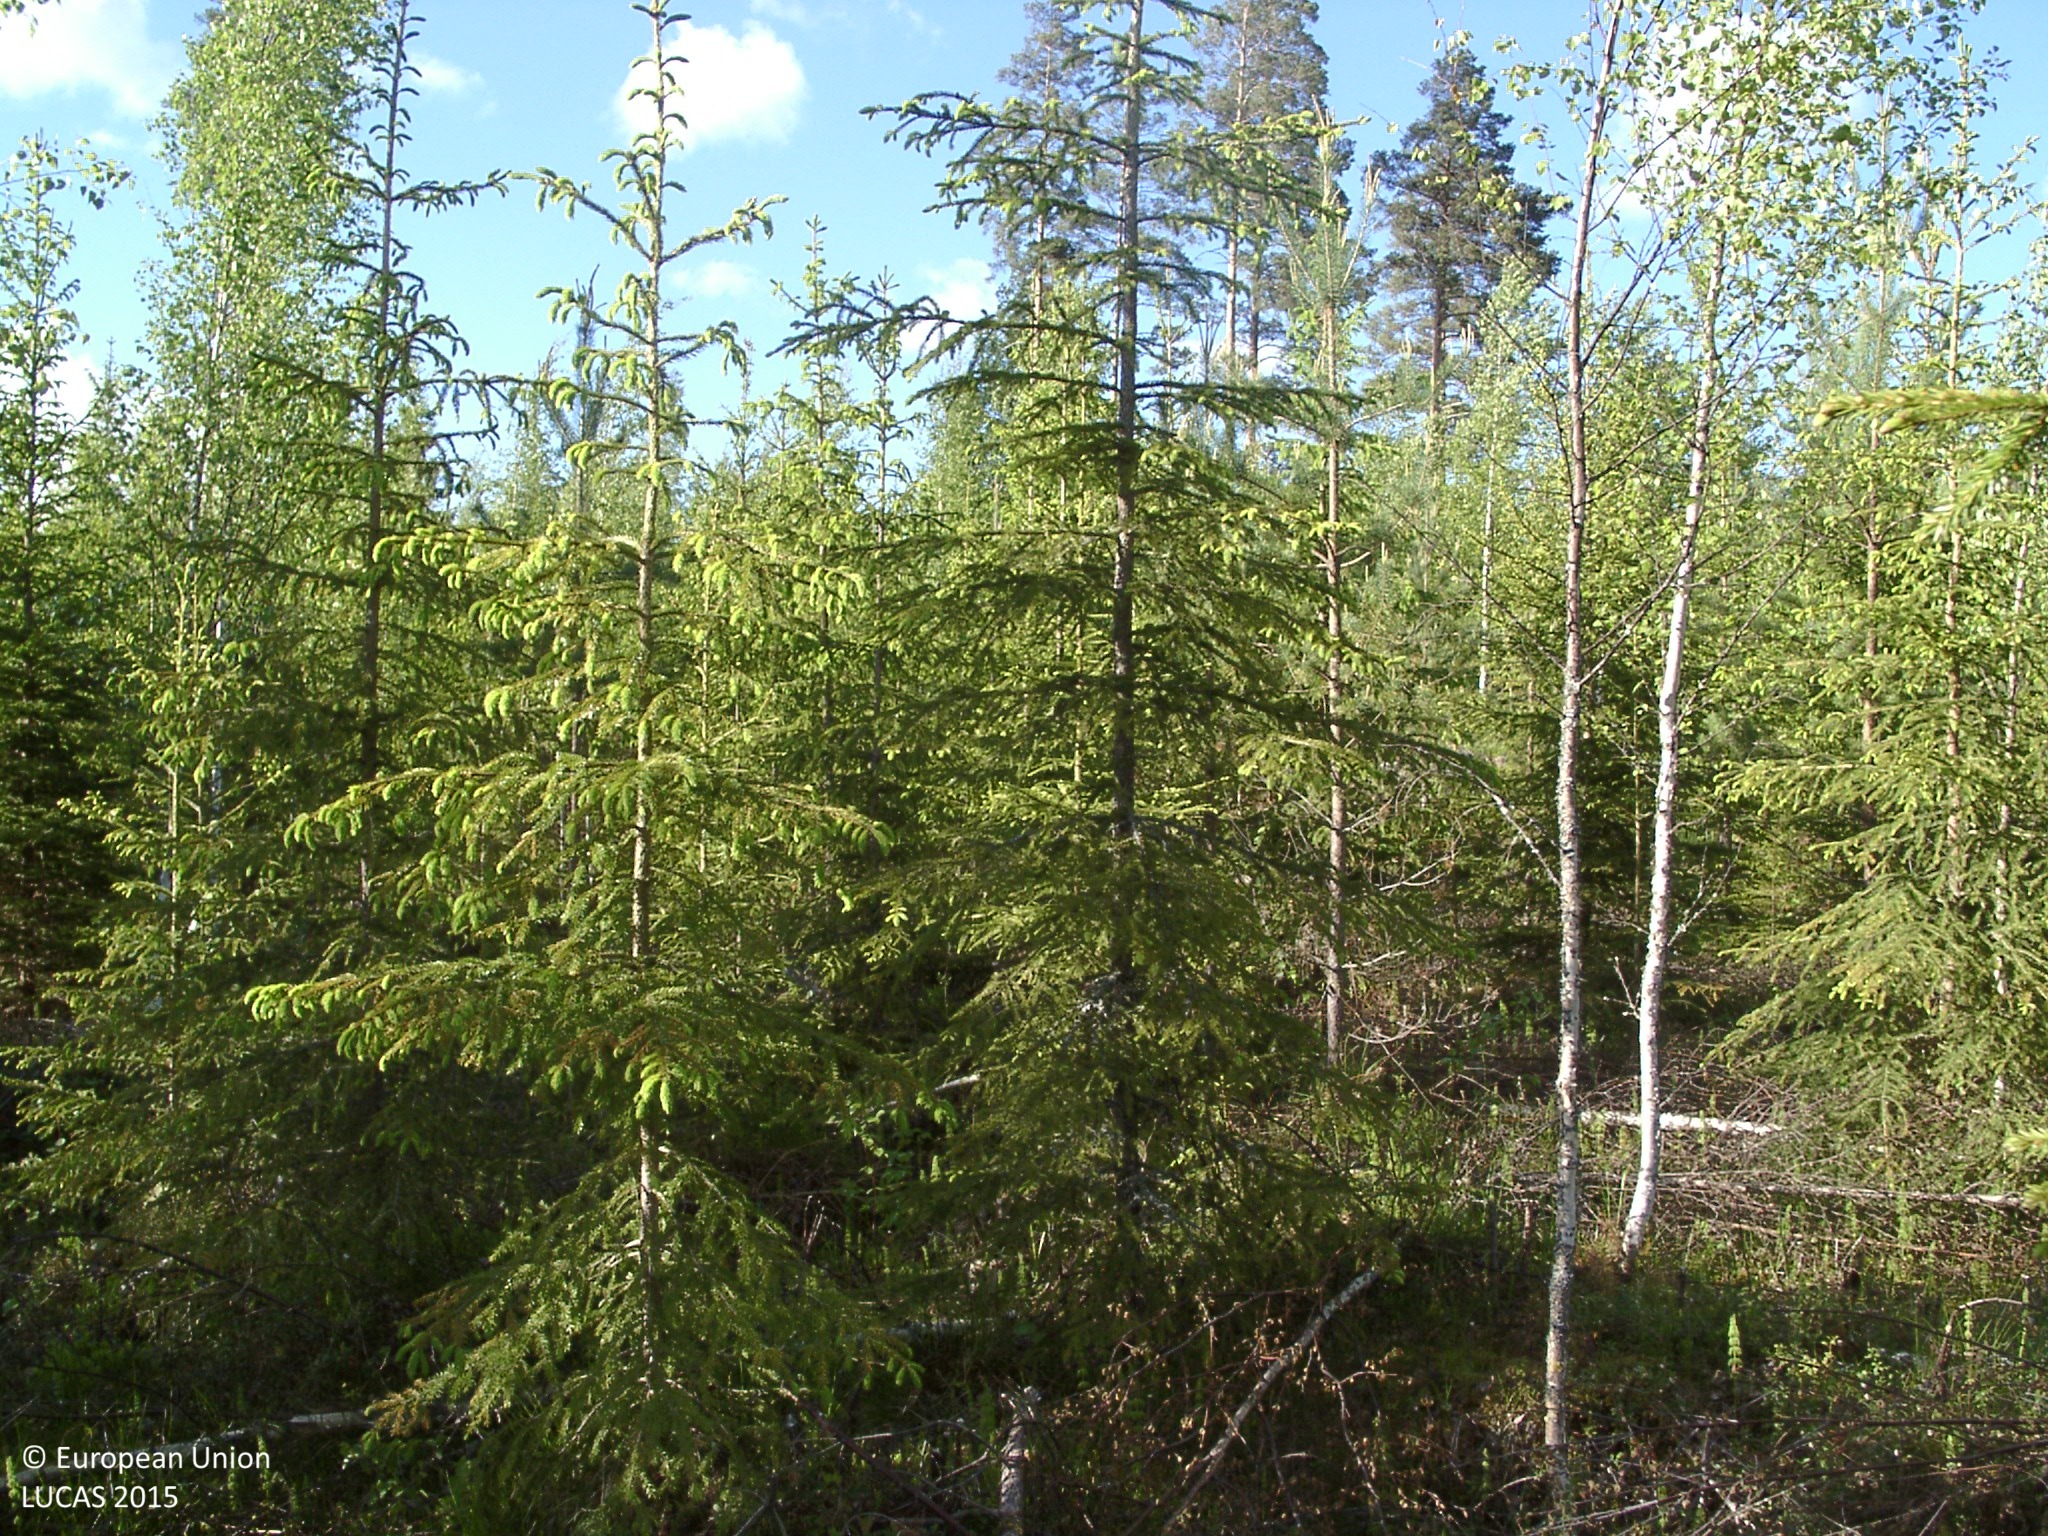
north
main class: Woodland
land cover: Other mixed woodland
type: boreal forest
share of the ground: 25 - 50 %
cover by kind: coniferous forest trees 30 %, shrubs 25 %, broadleaved forest trees 10 %, lichens and mosses 10 %, herbaceous plants 5 %
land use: Forestry
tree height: < 5 m
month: June
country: FI
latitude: 61.7371
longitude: 24.8899
